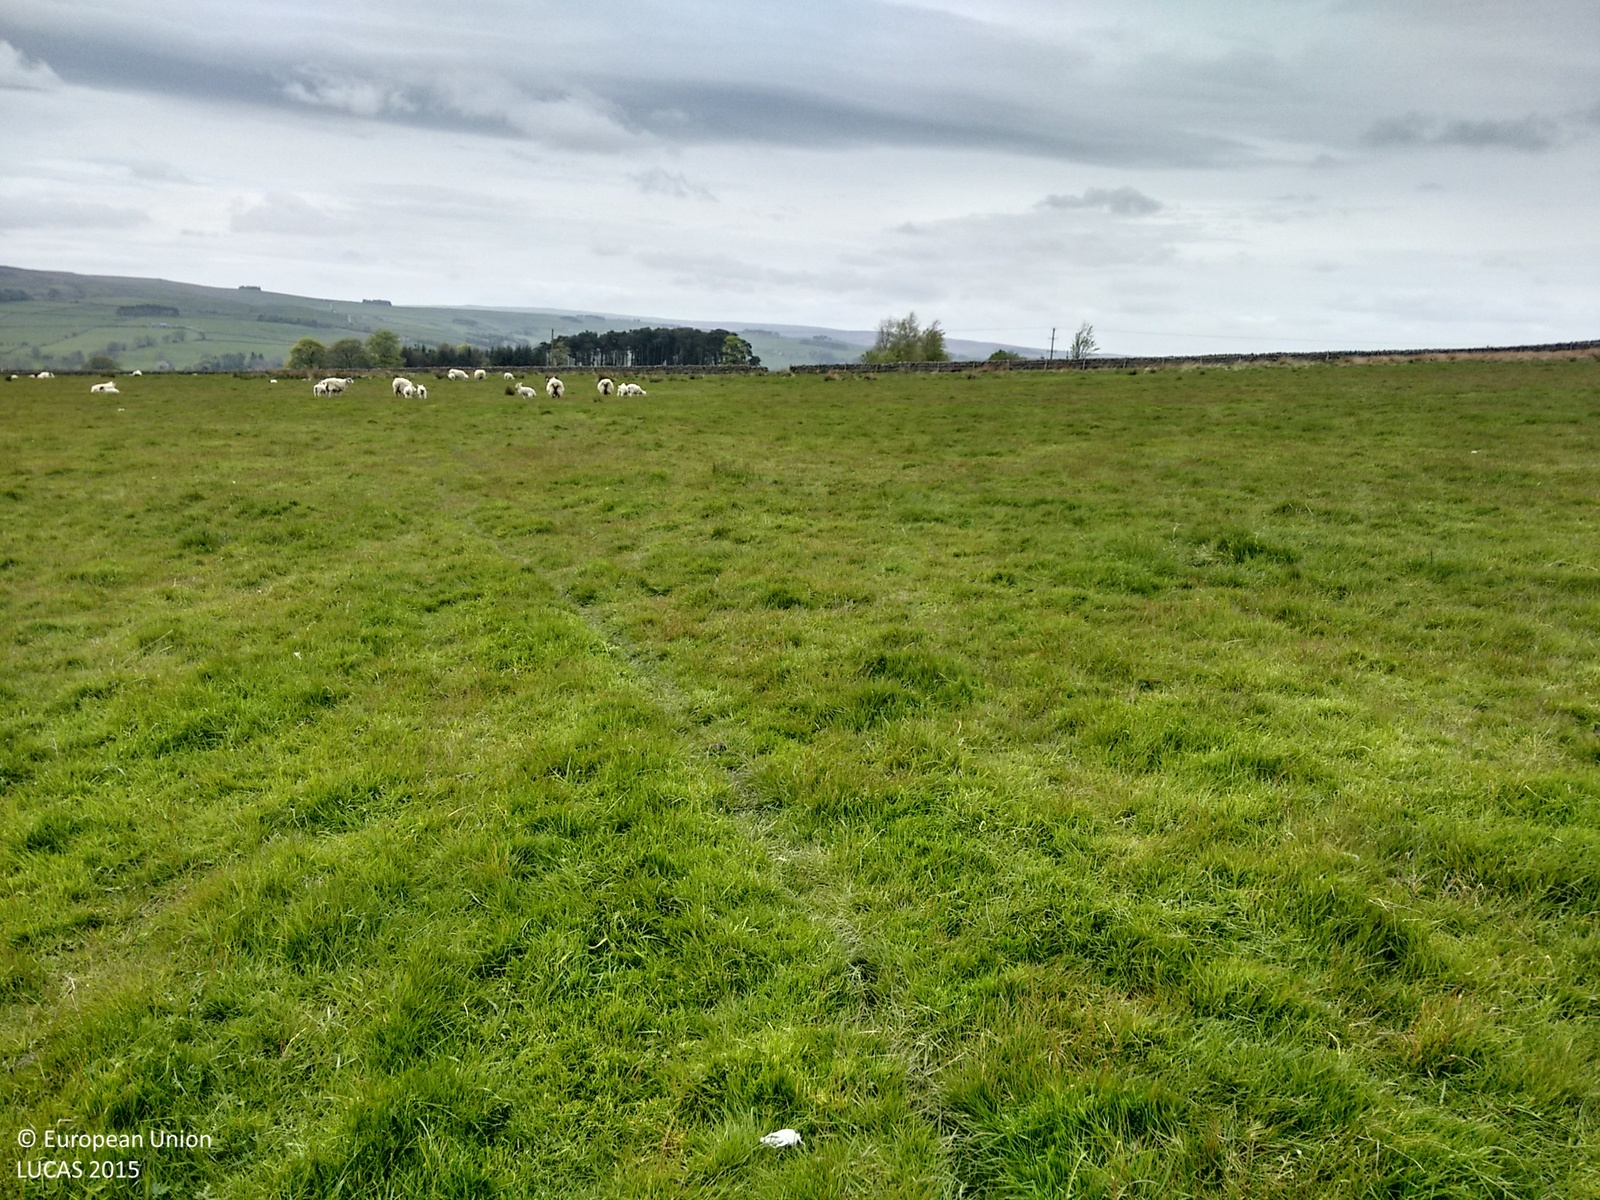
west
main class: Grassland
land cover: Grassland without tree/shrub cover
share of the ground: > 75 %
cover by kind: herbaceous plants 100 %
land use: Agriculture (excluding fallow land and kitchen gardens)
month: May
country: GB
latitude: 54.9073
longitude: -2.2398
